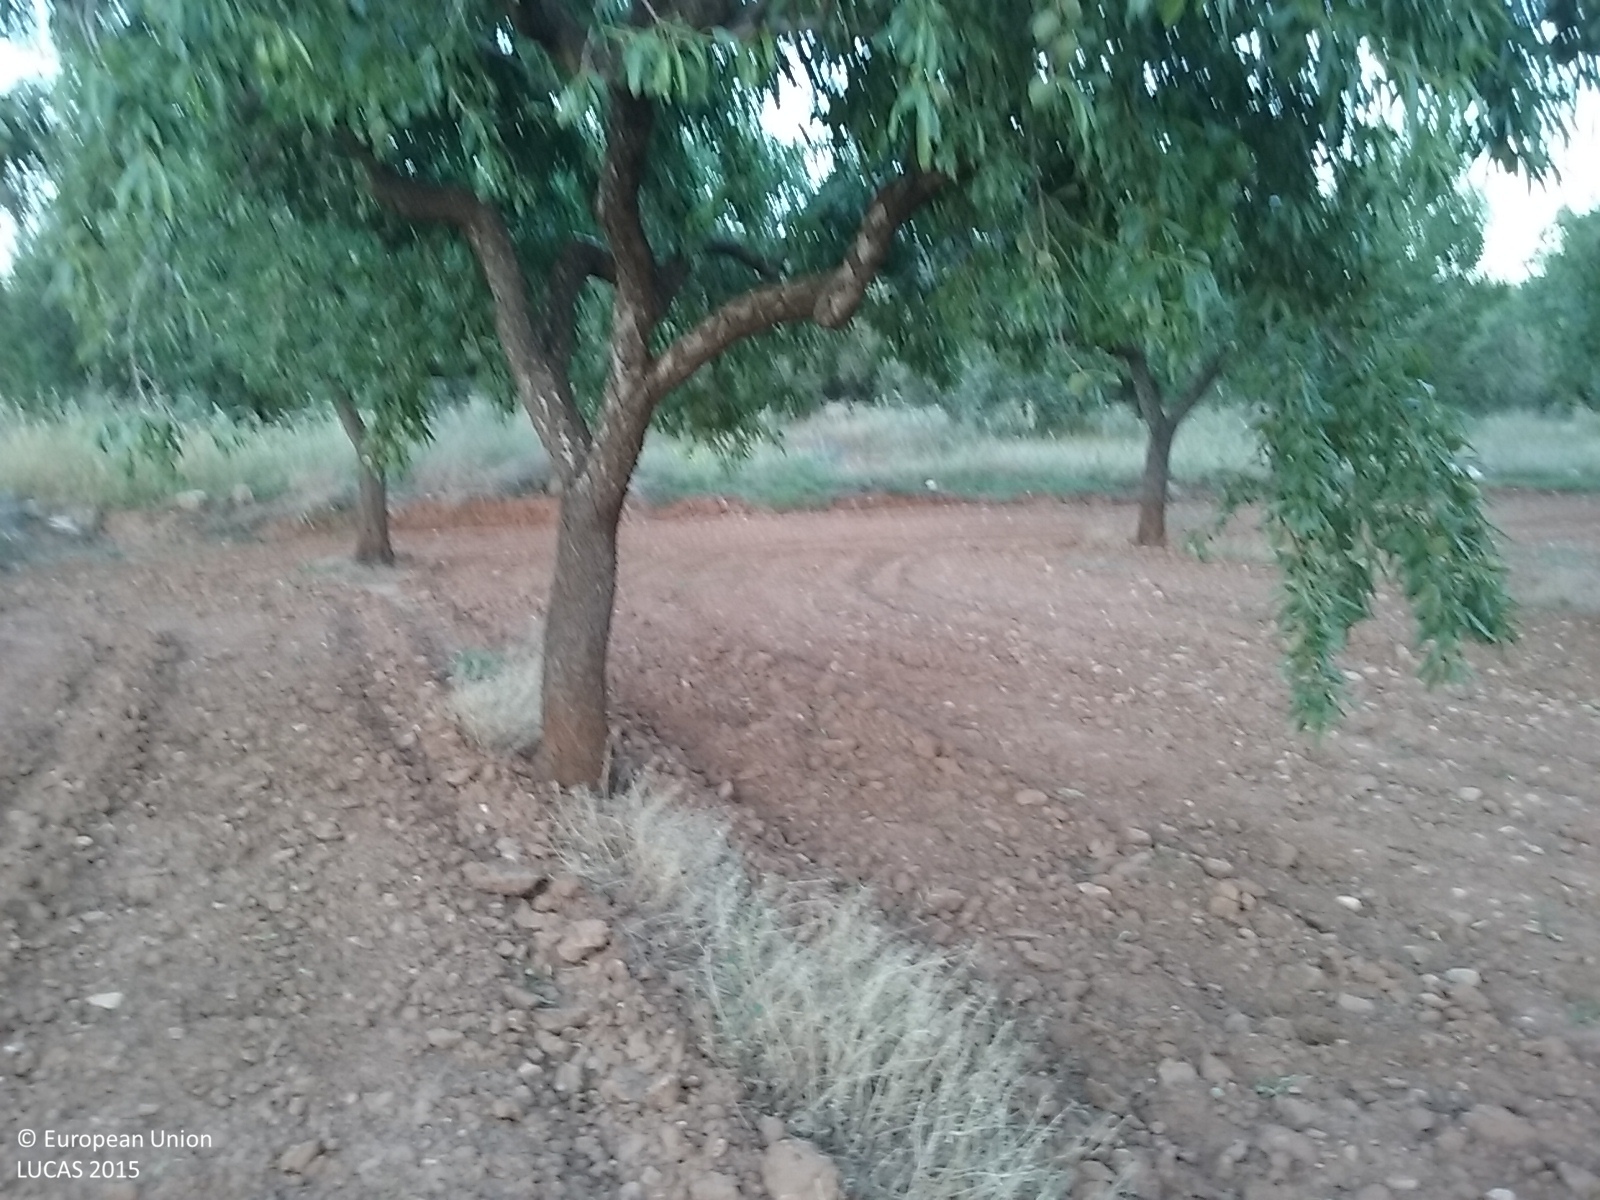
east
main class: Cropland
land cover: Nuts trees
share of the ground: 50 - 75 %
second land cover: Other bare soil
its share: > 75 %
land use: Agriculture (excluding fallow land and kitchen gardens)
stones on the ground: < 10 %
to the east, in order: Nuts trees; Other bare soil; Grass margins; Olive groves; Grass margins; Nuts trees; Grass margins; Ditches and canals; Paved roads, cycling and walking lanes; Dry stone walls; Nuts trees; Shrubland with sparse tree cover
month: May
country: ES
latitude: 40.1853
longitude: -0.0686
